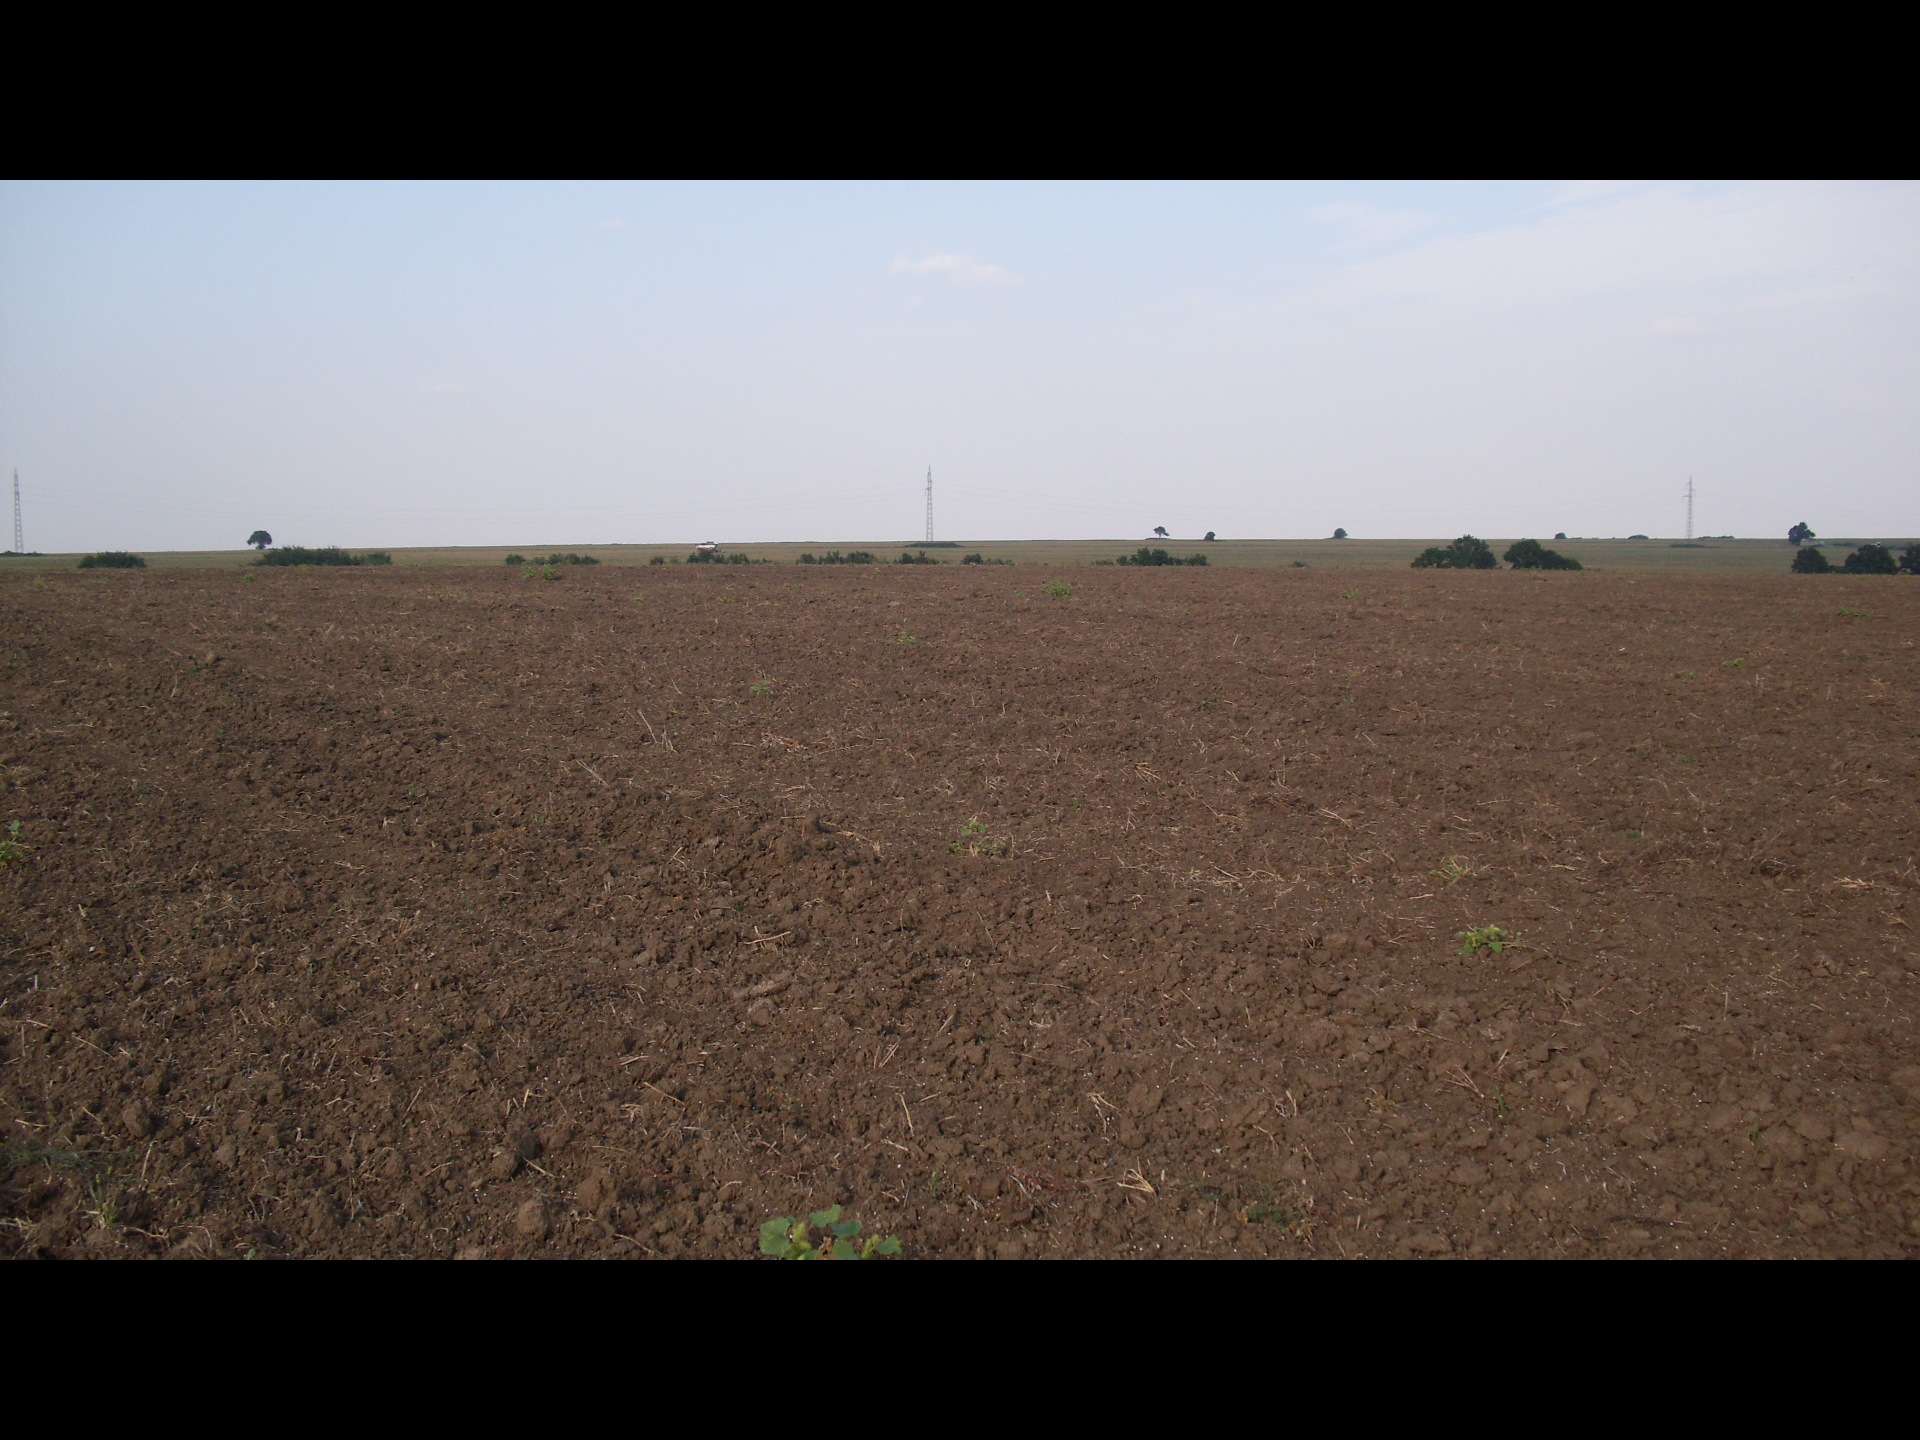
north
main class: Cropland
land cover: Rape and turnip rape
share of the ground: < 10 %
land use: Agriculture (excluding fallow land and kitchen gardens)
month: September
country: BG
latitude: 43.4583
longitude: 23.4028
